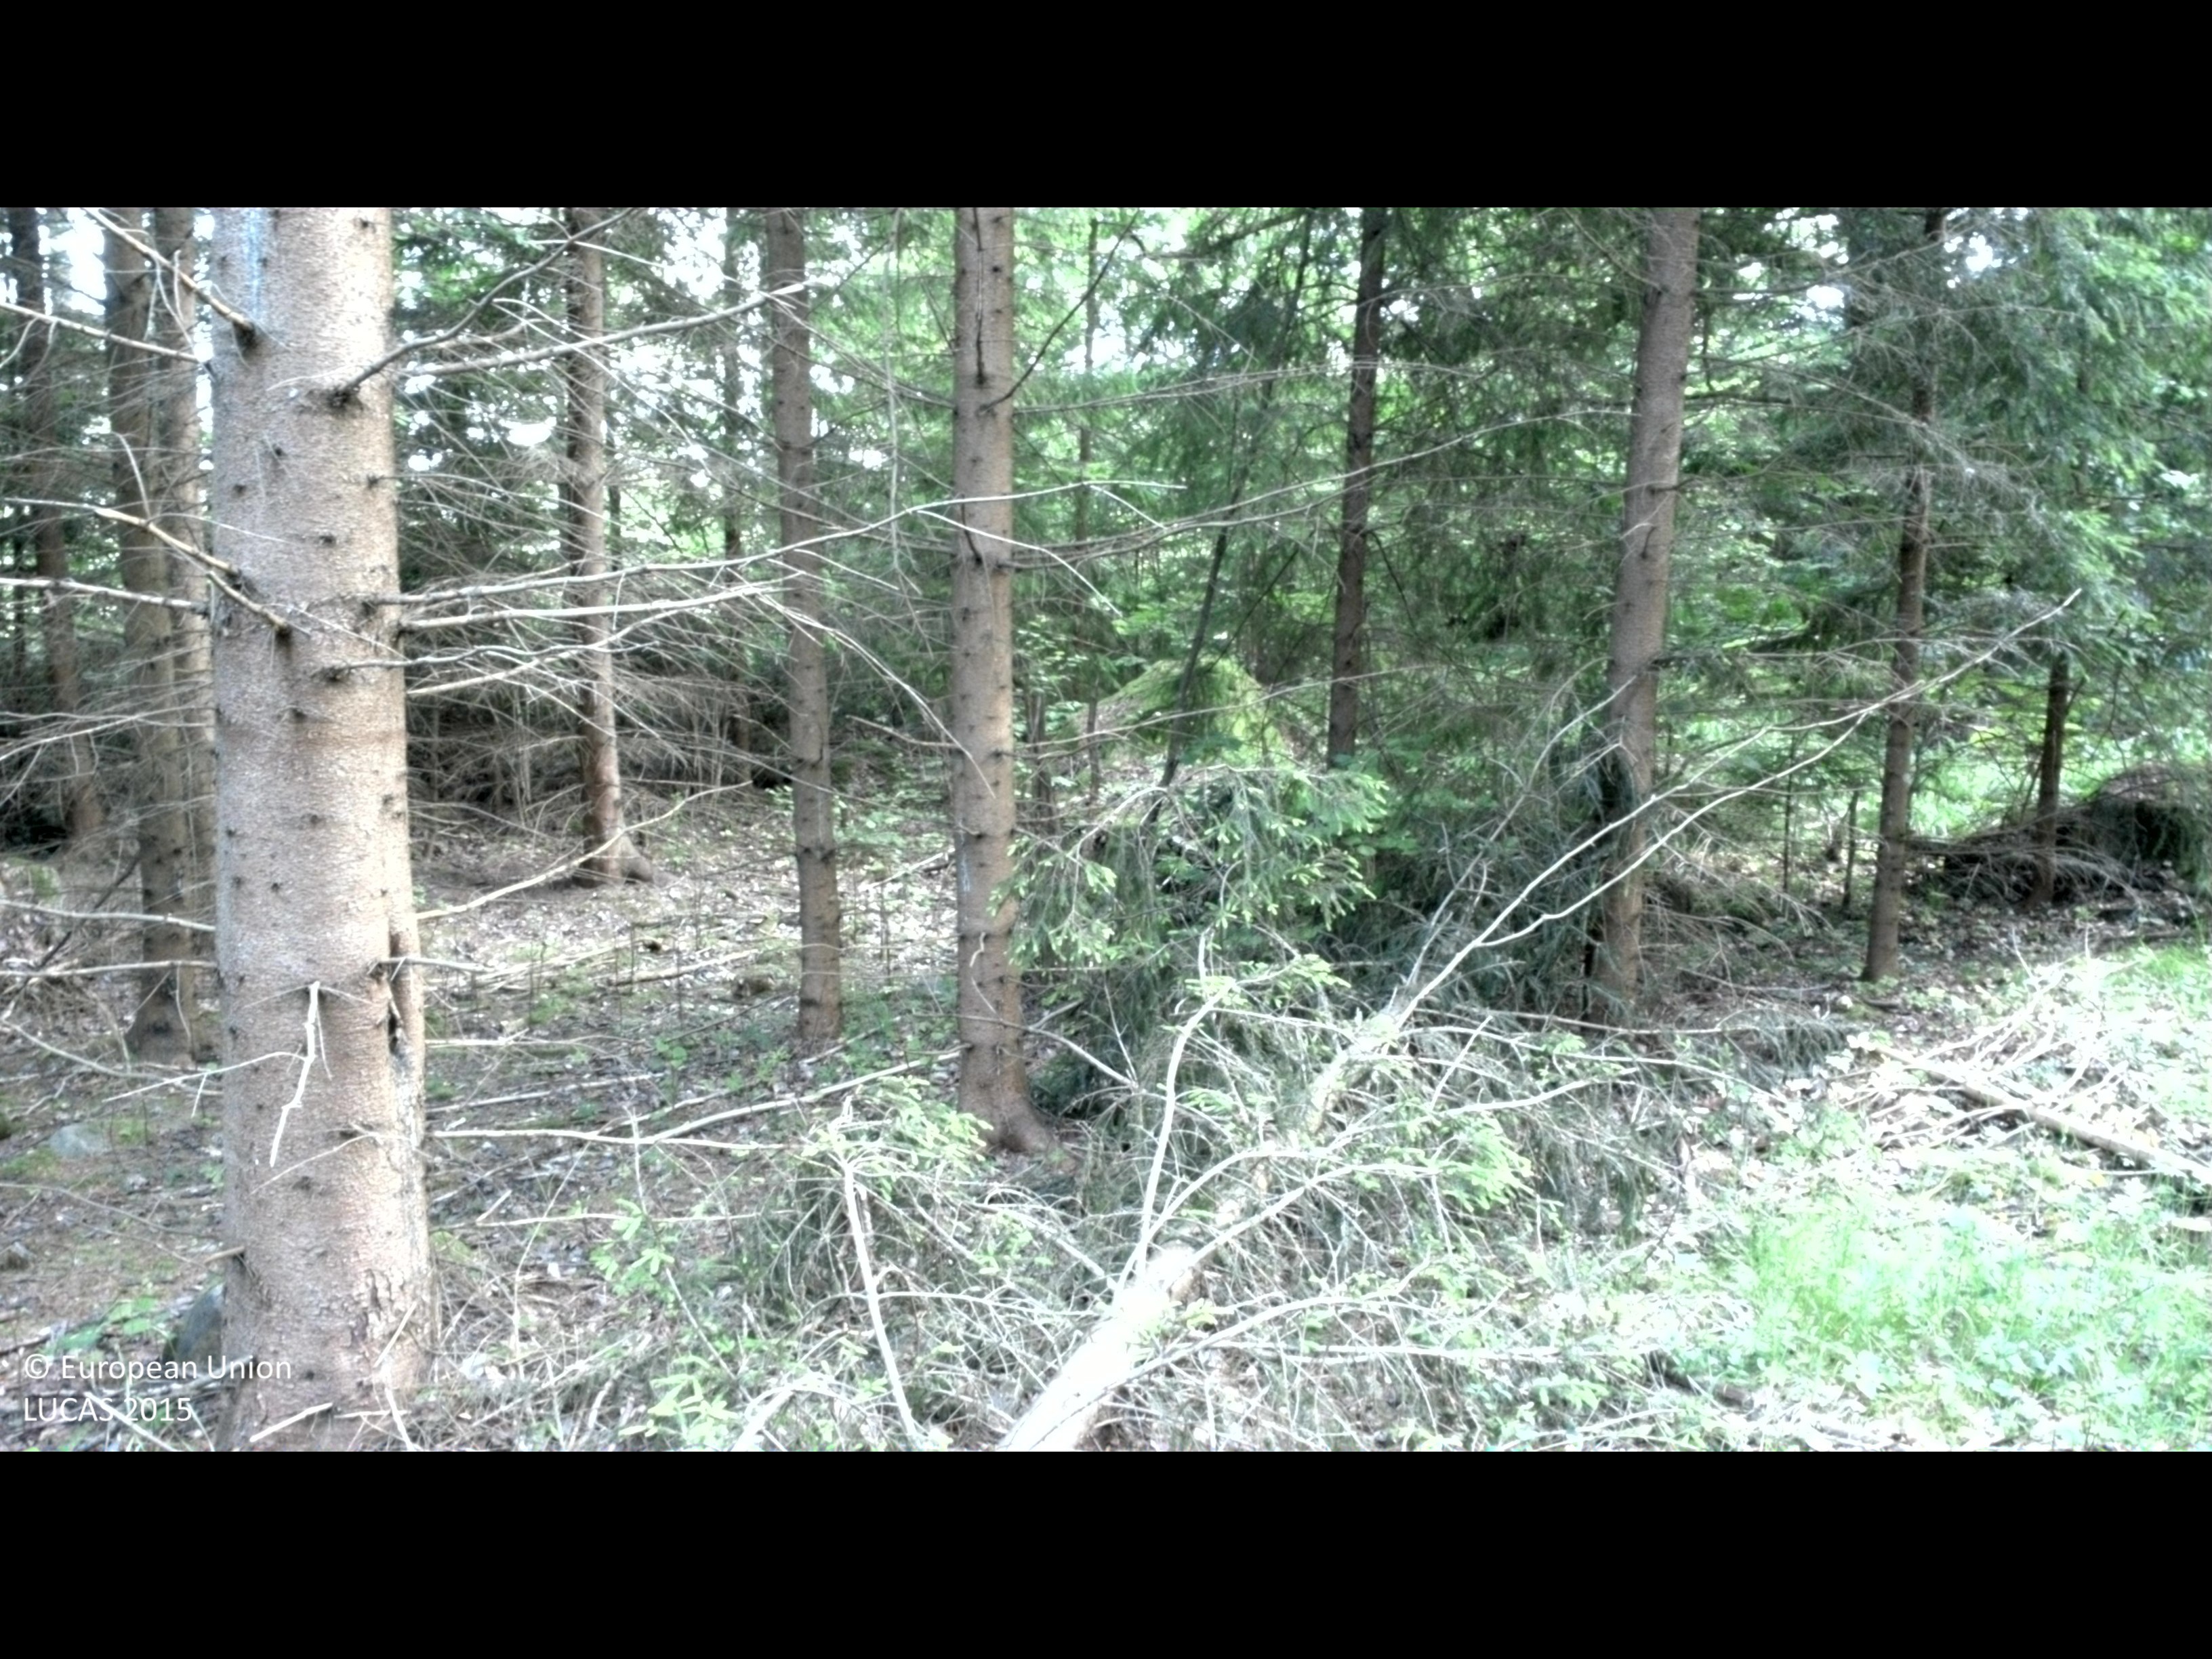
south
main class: Woodland
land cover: Spruce dominated coniferous woodland
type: boreal forest
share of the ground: > 75 %
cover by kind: coniferous forest trees 70 %, broadleaved forest trees 10 %, shrubs 10 %, herbaceous plants 5 %, lichens and mosses 5 %
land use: Forestry
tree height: > 5 m
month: June
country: SE
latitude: 58.2398
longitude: 16.1792
